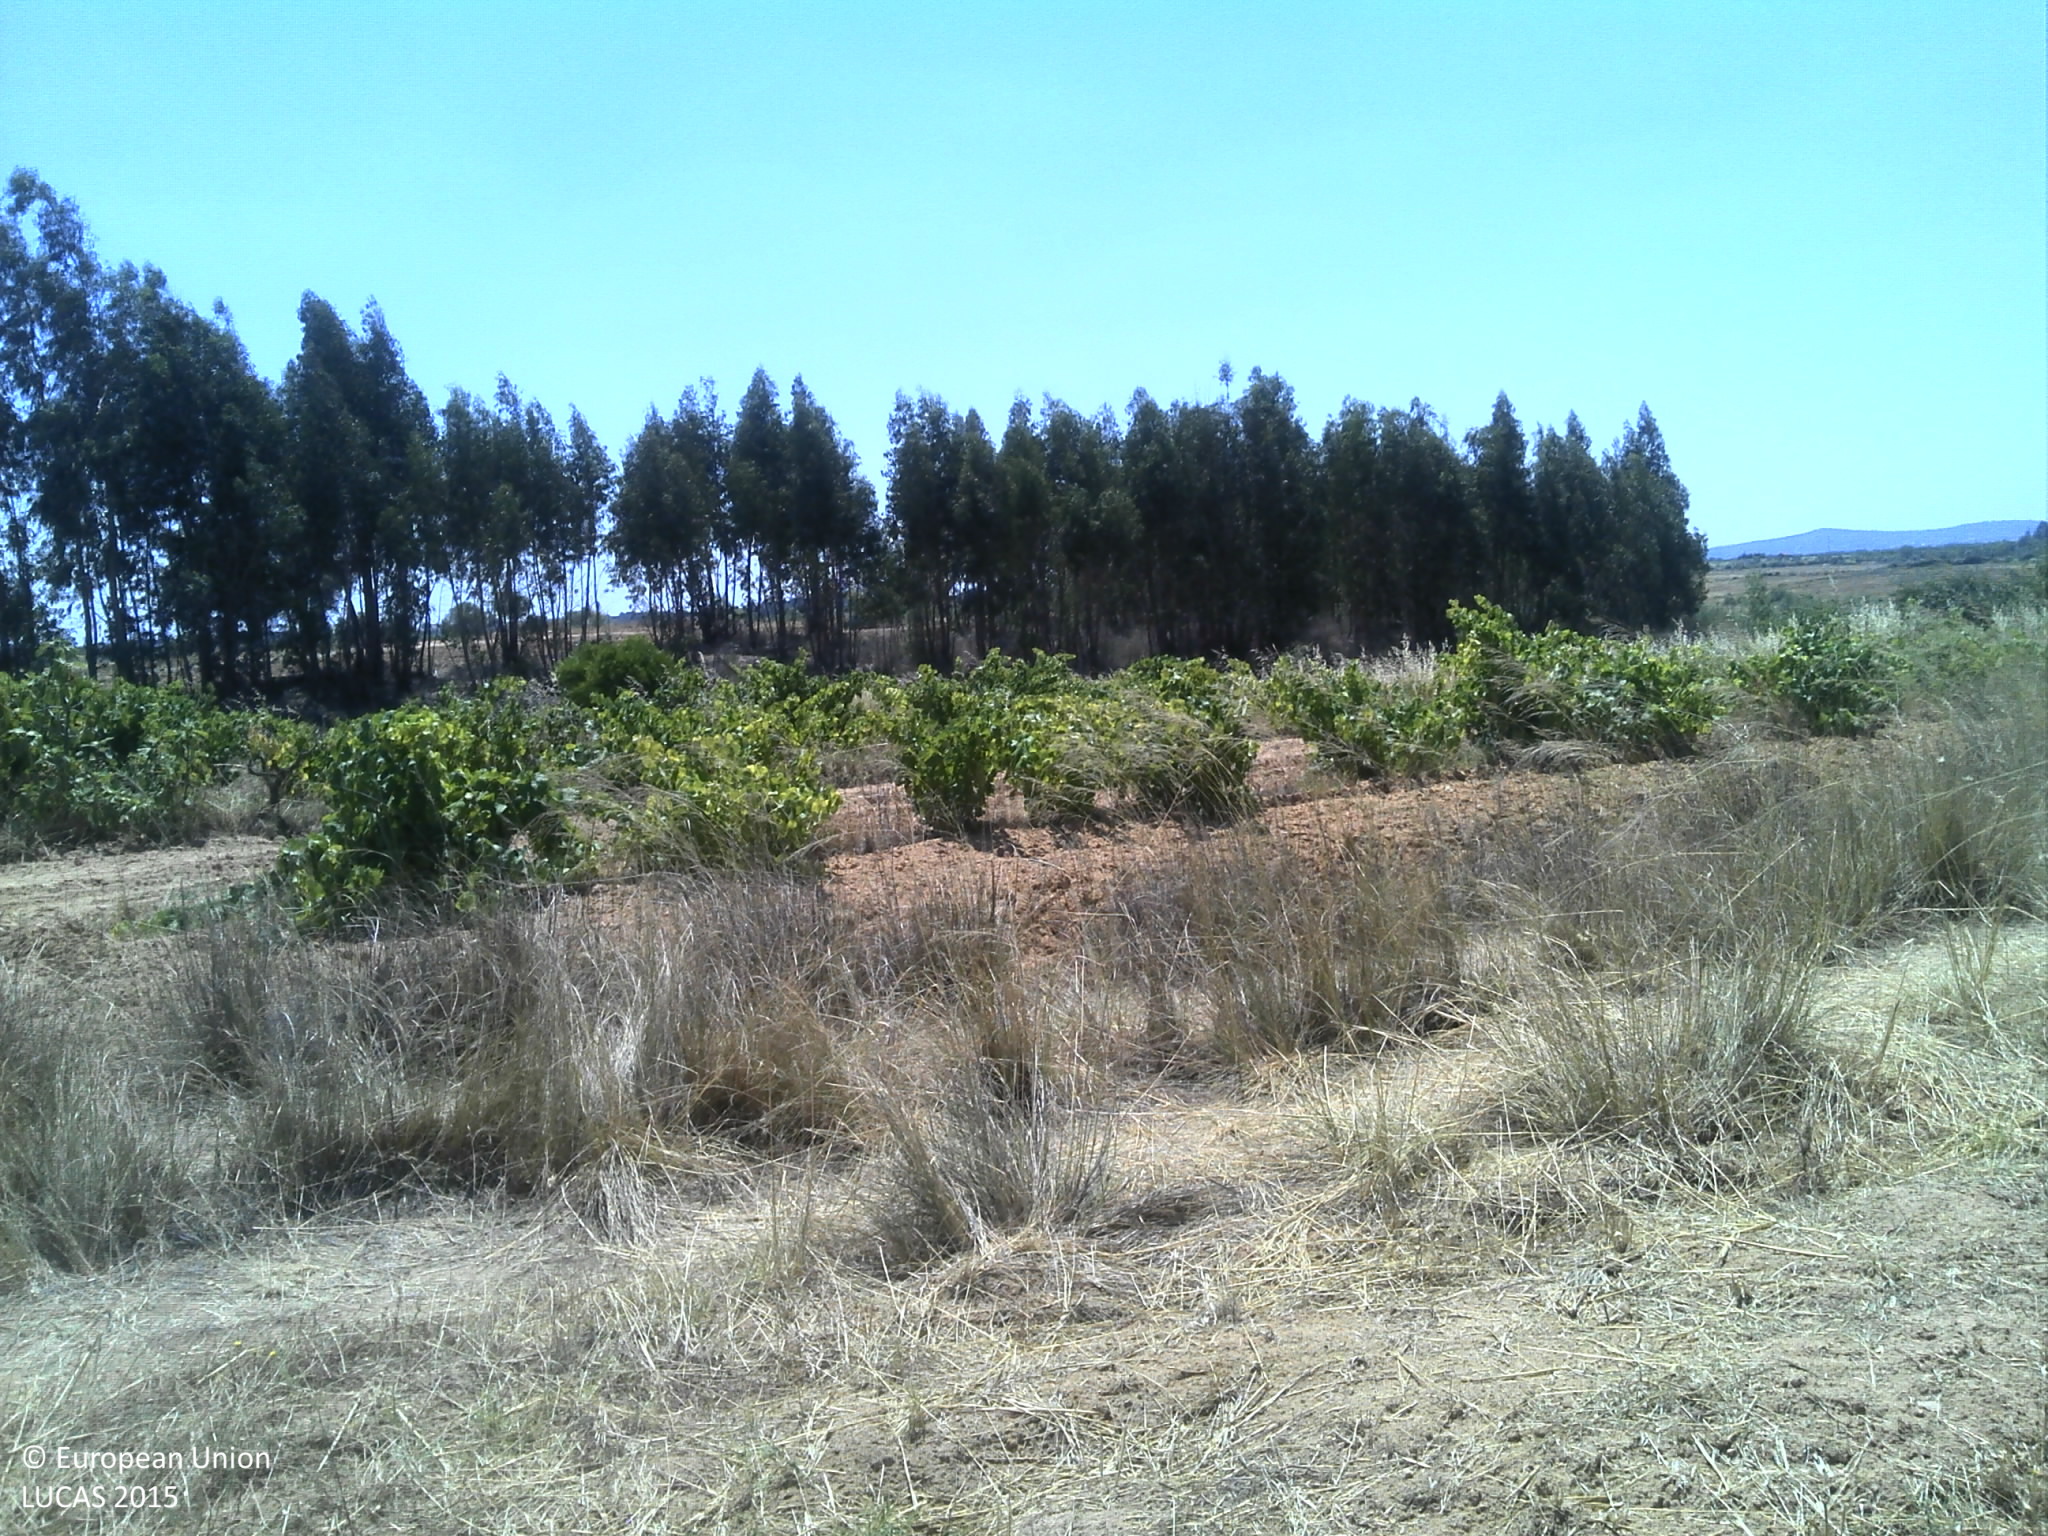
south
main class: Grassland
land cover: Grassland without tree/shrub cover
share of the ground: 10 - 25 %
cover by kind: unconsolidated bare surface 85 %, herbaceous plants 10 %
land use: Agriculture (excluding fallow land and kitchen gardens)
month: June
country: PT
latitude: 39.8453
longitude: -7.2860
